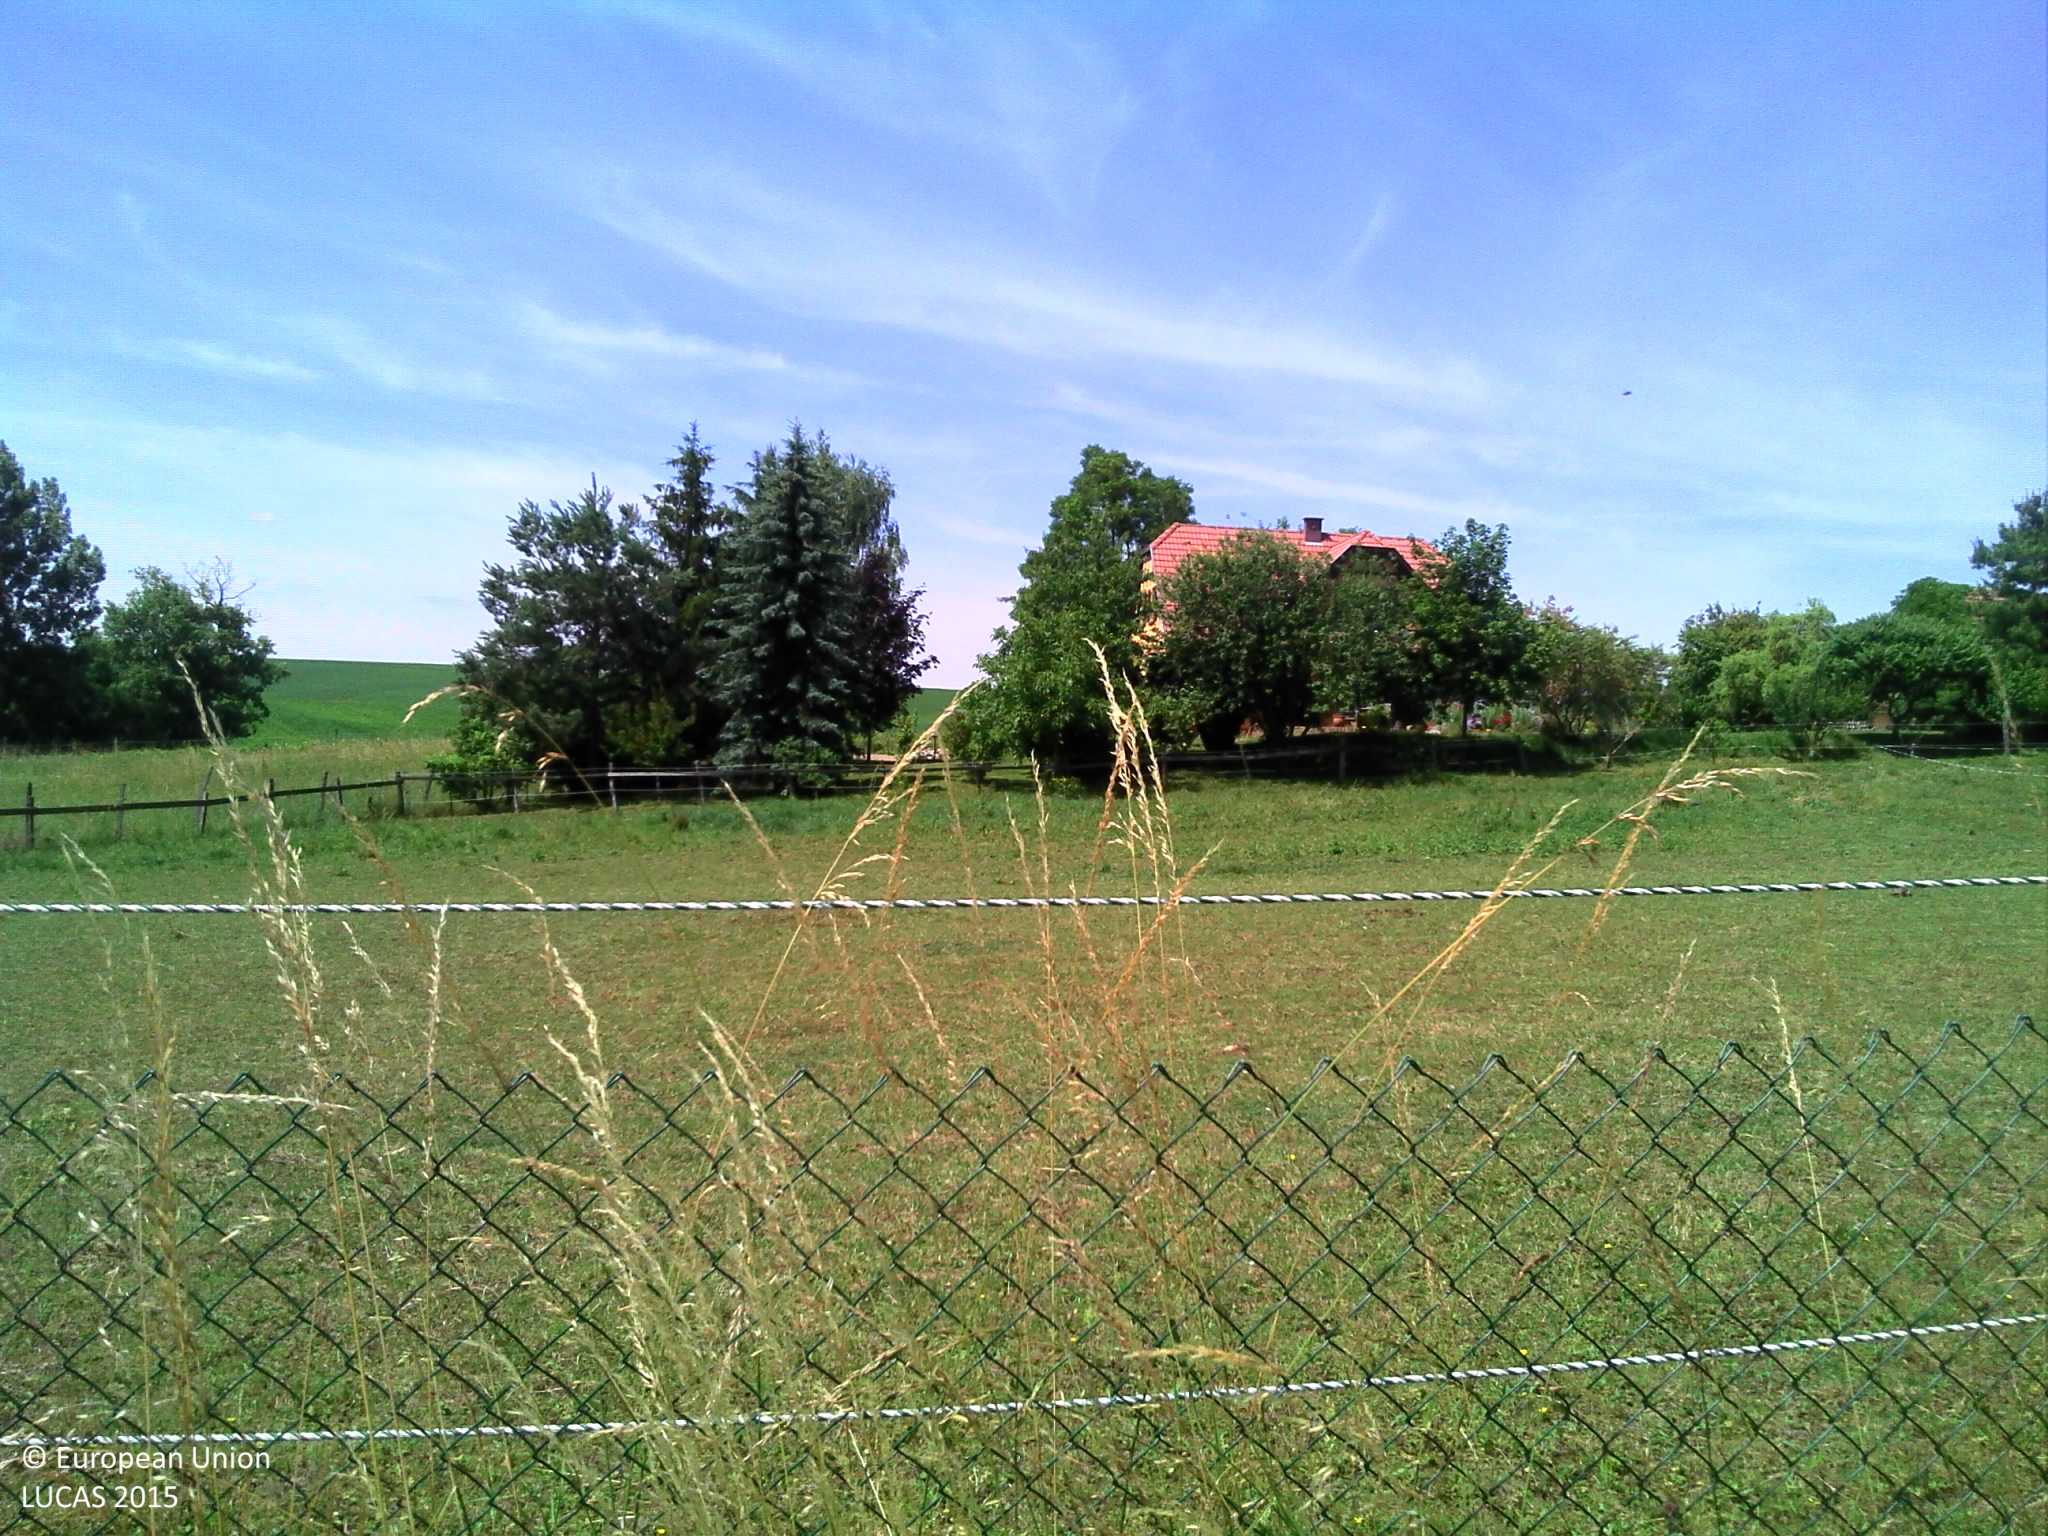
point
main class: Grassland
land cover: Grassland without tree/shrub cover
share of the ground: > 75 %
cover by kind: herbaceous plants 100 %
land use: Agriculture (excluding fallow land and kitchen gardens)
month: June
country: FR
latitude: 48.7193
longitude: 7.5949
